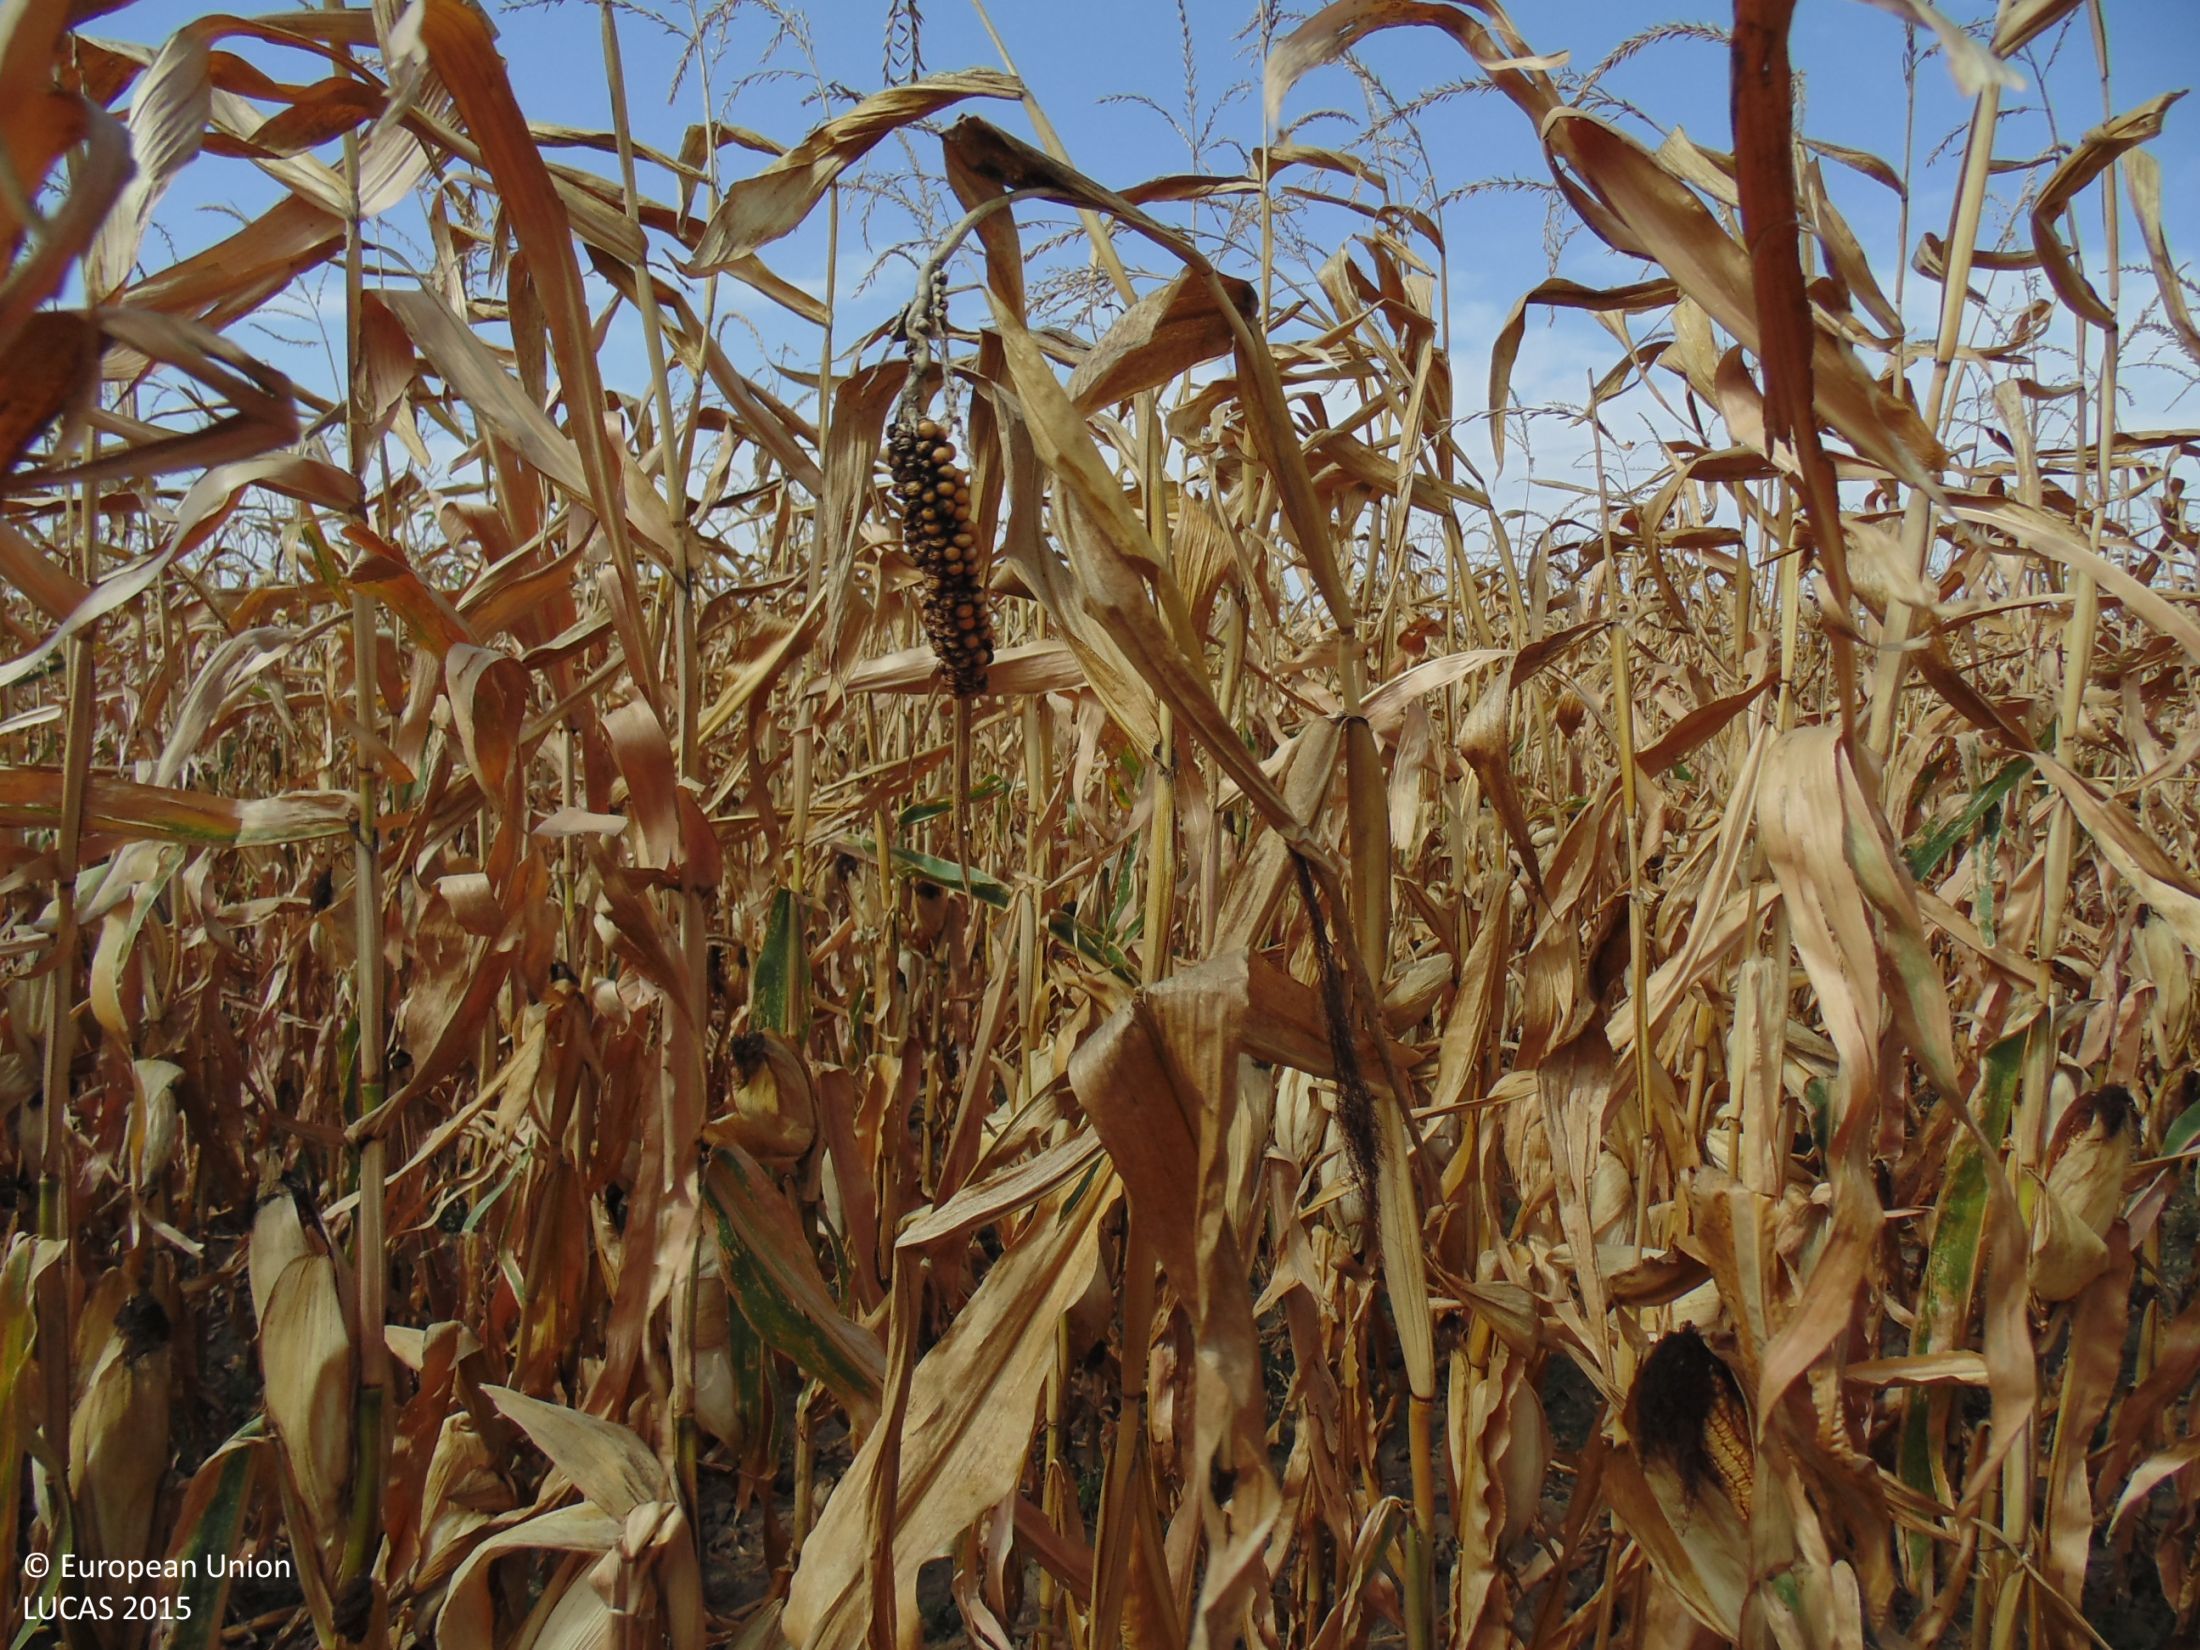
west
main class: Cropland
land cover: Maize
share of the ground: > 75 %
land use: Agriculture (excluding fallow land and kitchen gardens)
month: September
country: BG
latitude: 44.0402
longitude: 27.2137
